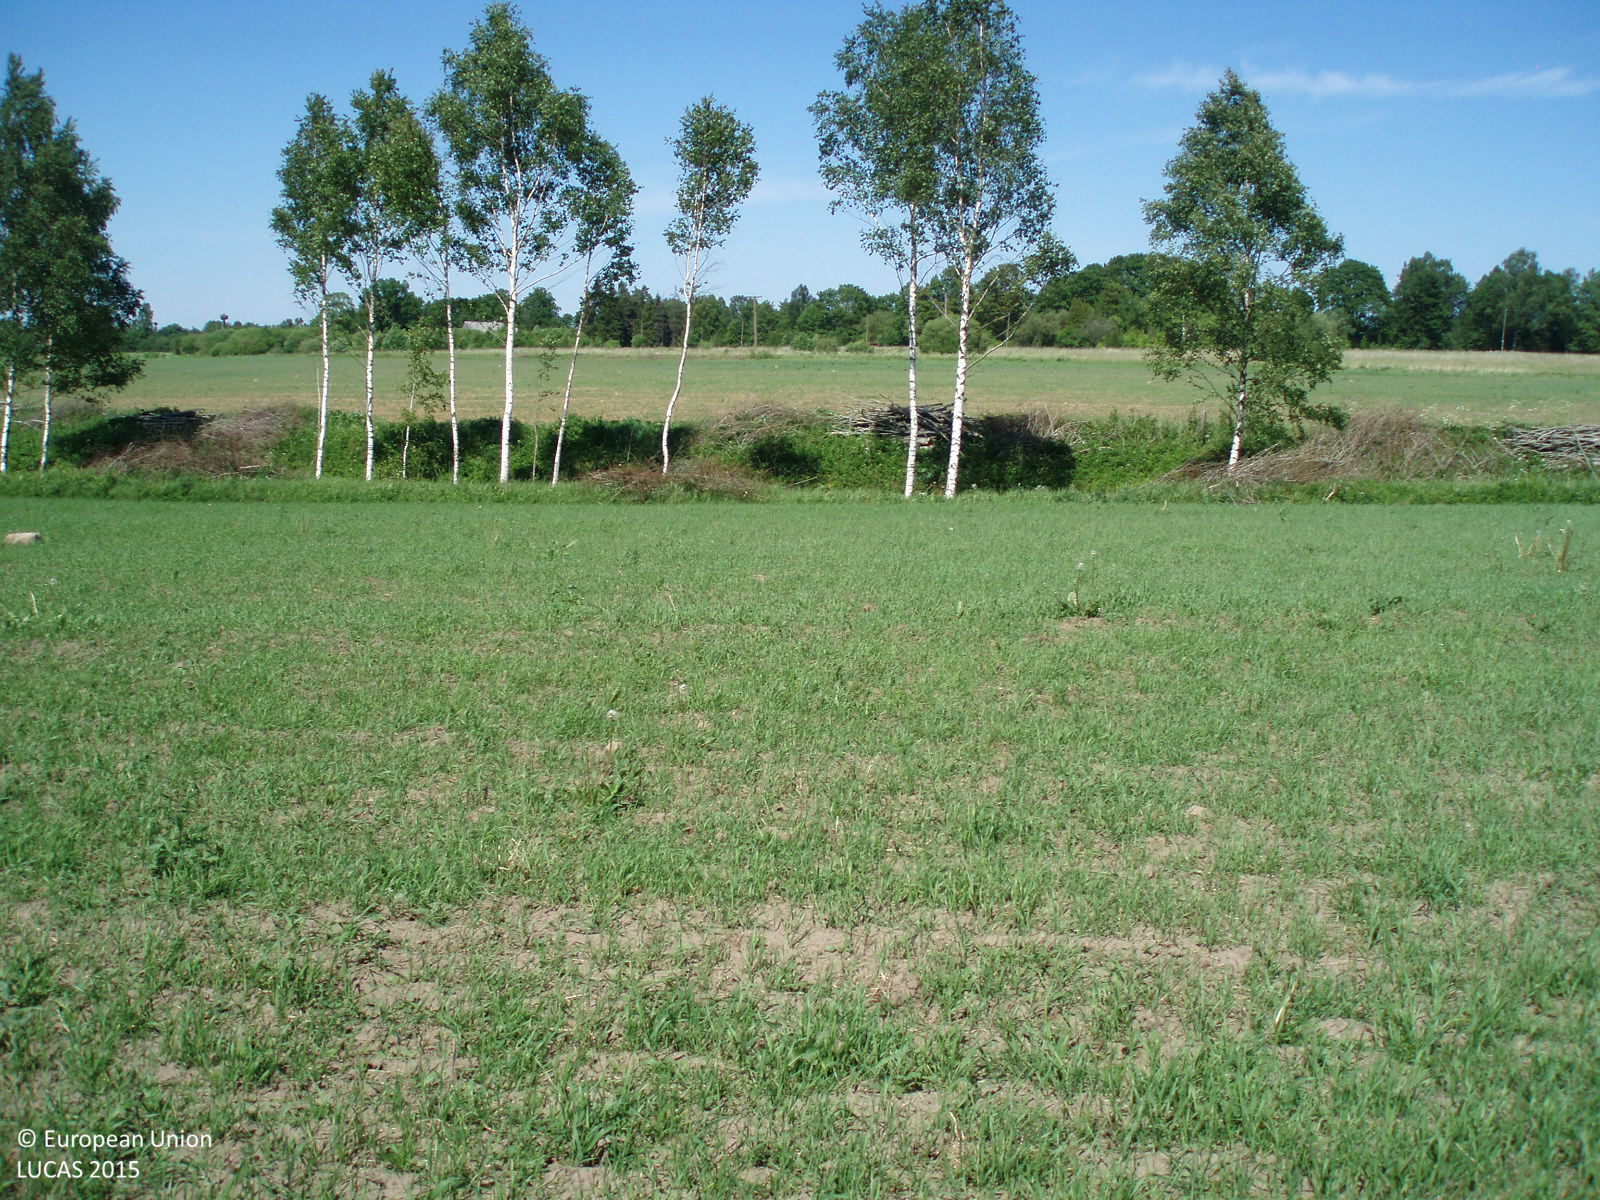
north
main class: Cropland
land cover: Rye
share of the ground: > 75 %
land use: Agriculture (excluding fallow land and kitchen gardens)
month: June
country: LT
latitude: 56.2206
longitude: 22.5904
